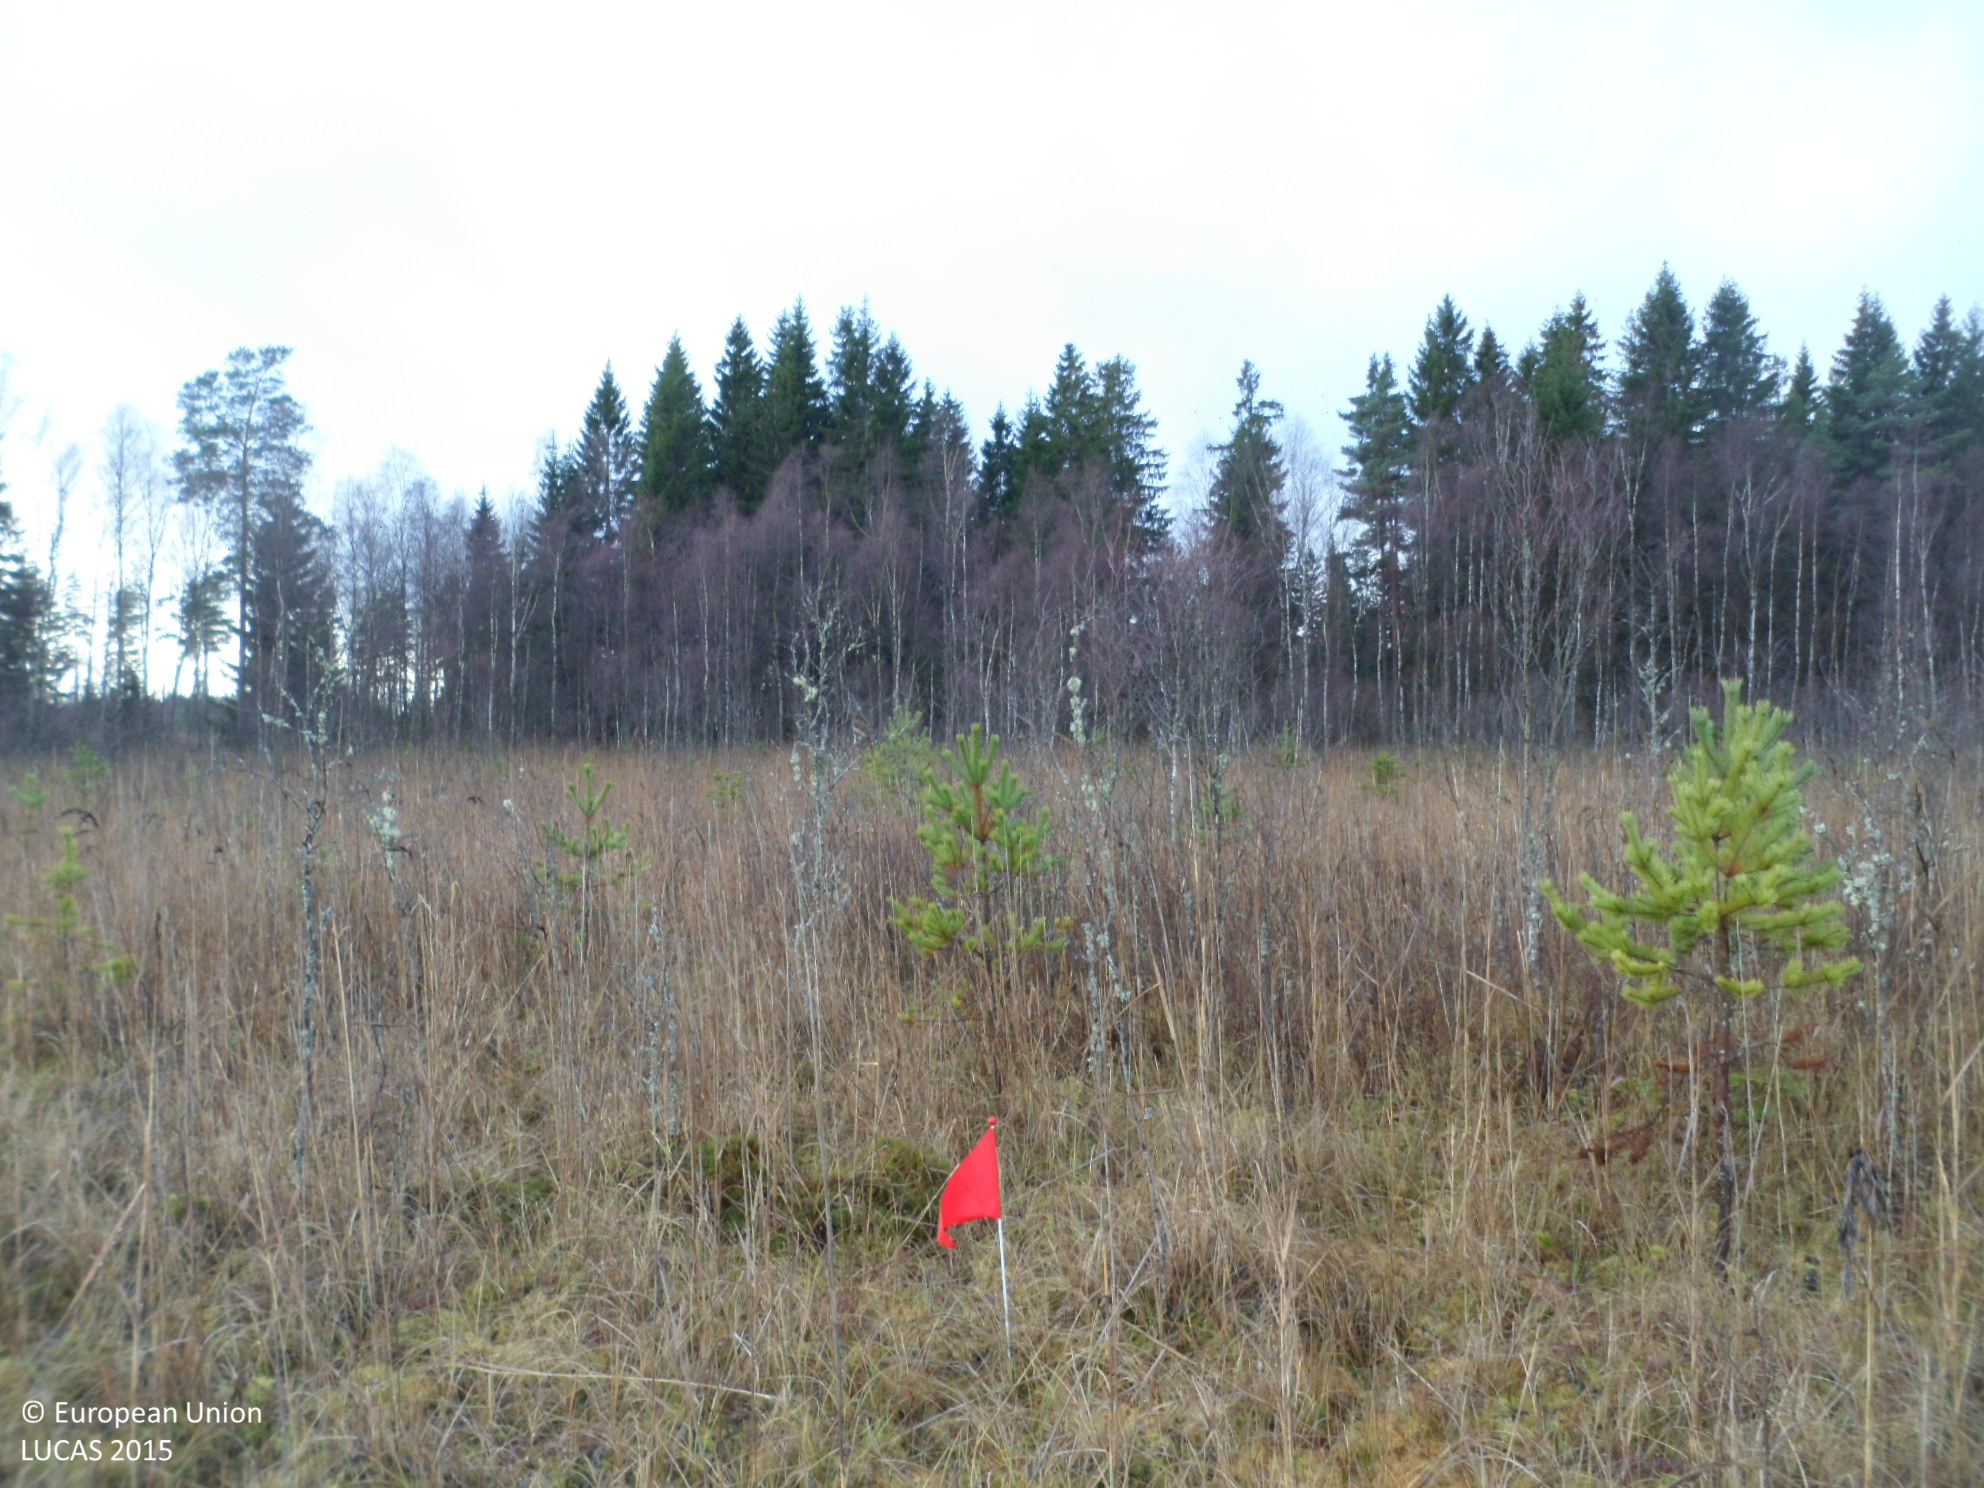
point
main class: Woodland
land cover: Pine dominated mixed woodland
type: mire and swamp forests
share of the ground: 10 - 25 %
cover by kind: lichens and mosses 40 %, herbaceous plants 30 %, coniferous forest trees 10 %, broadleaved forest trees 10 %, shrubs 10 %
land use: Semi-natural and natural areas not in use
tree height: < 5 m
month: November
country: SE
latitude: 57.5625
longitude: 15.9986
